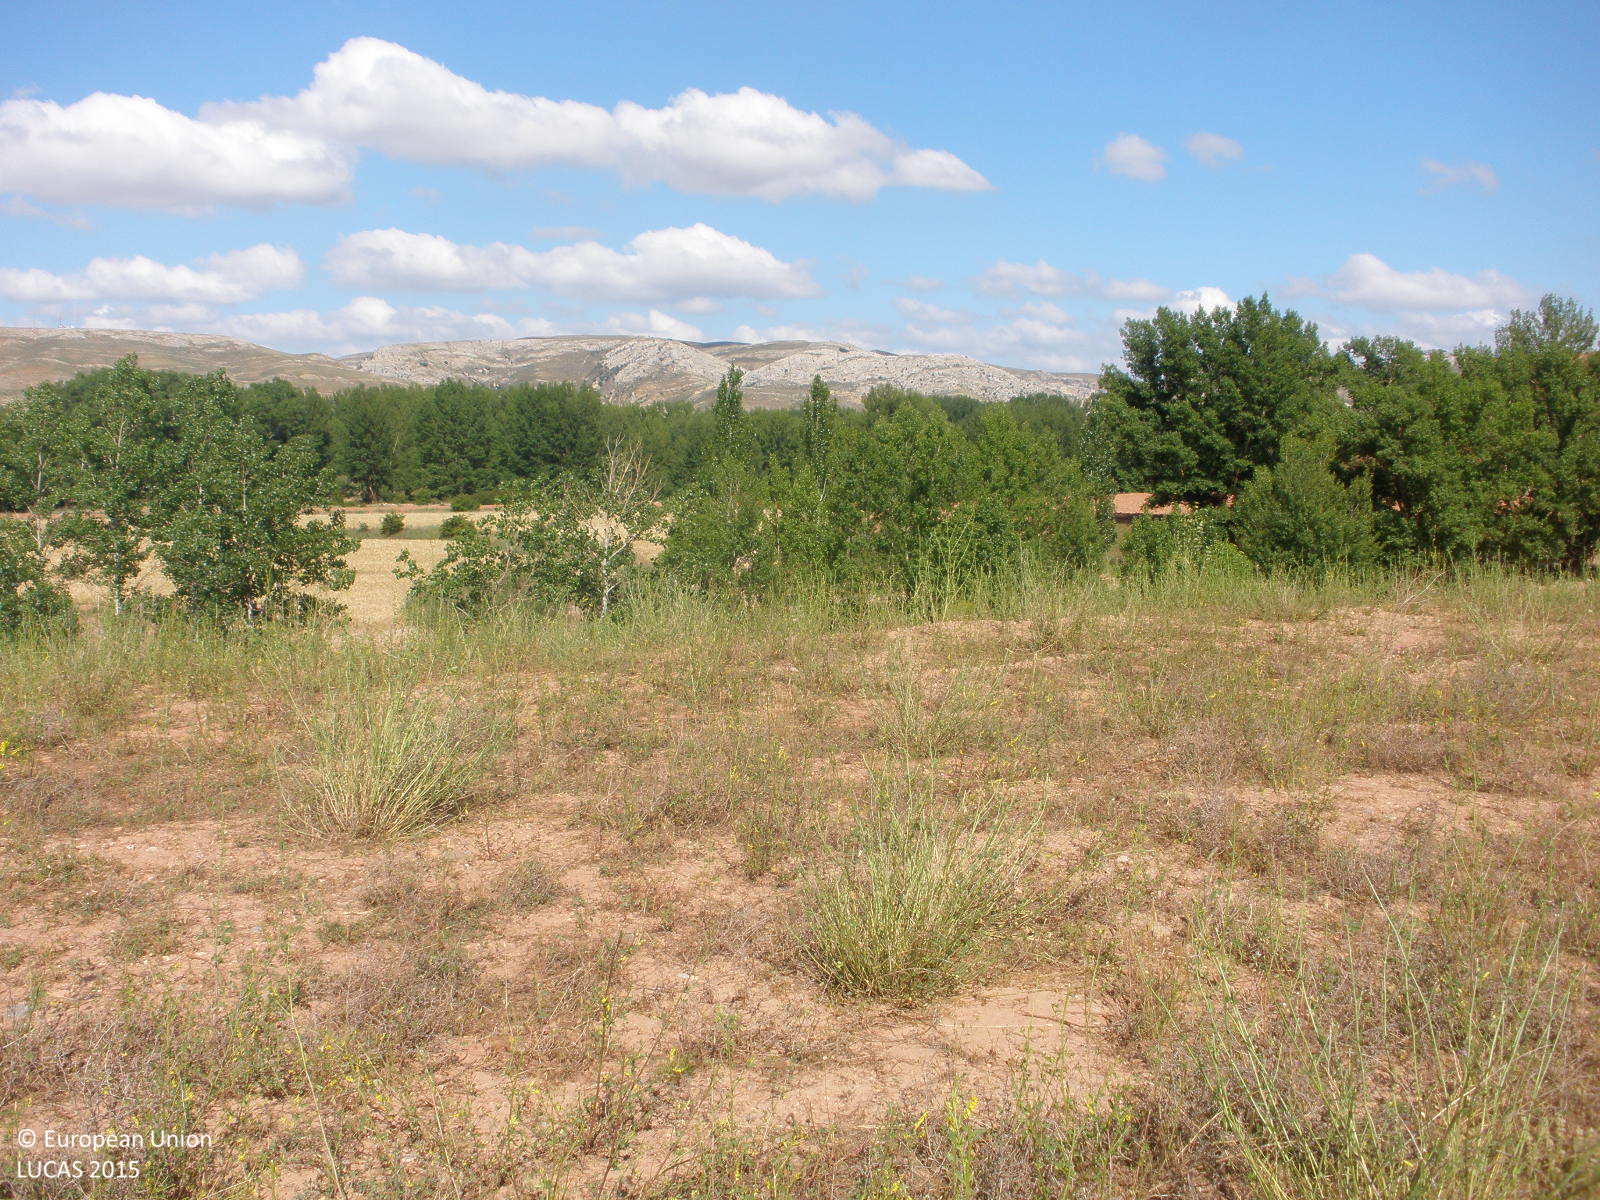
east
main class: Grassland
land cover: Spontaneously vegetated surfaces
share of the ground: > 75 %
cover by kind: herbaceous plants 80 %, unconsolidated bare surface 20 %
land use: Mining and quarrying
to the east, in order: Spontaneously vegetated surfaces; Fences; Spontaneously vegetated surfaces; Tracks; Abandoned hedges; Ditches and canals; Abandoned hedges; Tracks; Grassland with sparse tree/shrub cover; Tracks; Barley; Grass margins; Other bare soil; Shruby margins; Tracks; Shrubland without tree cover
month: June
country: ES
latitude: 40.6452
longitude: -0.8796
